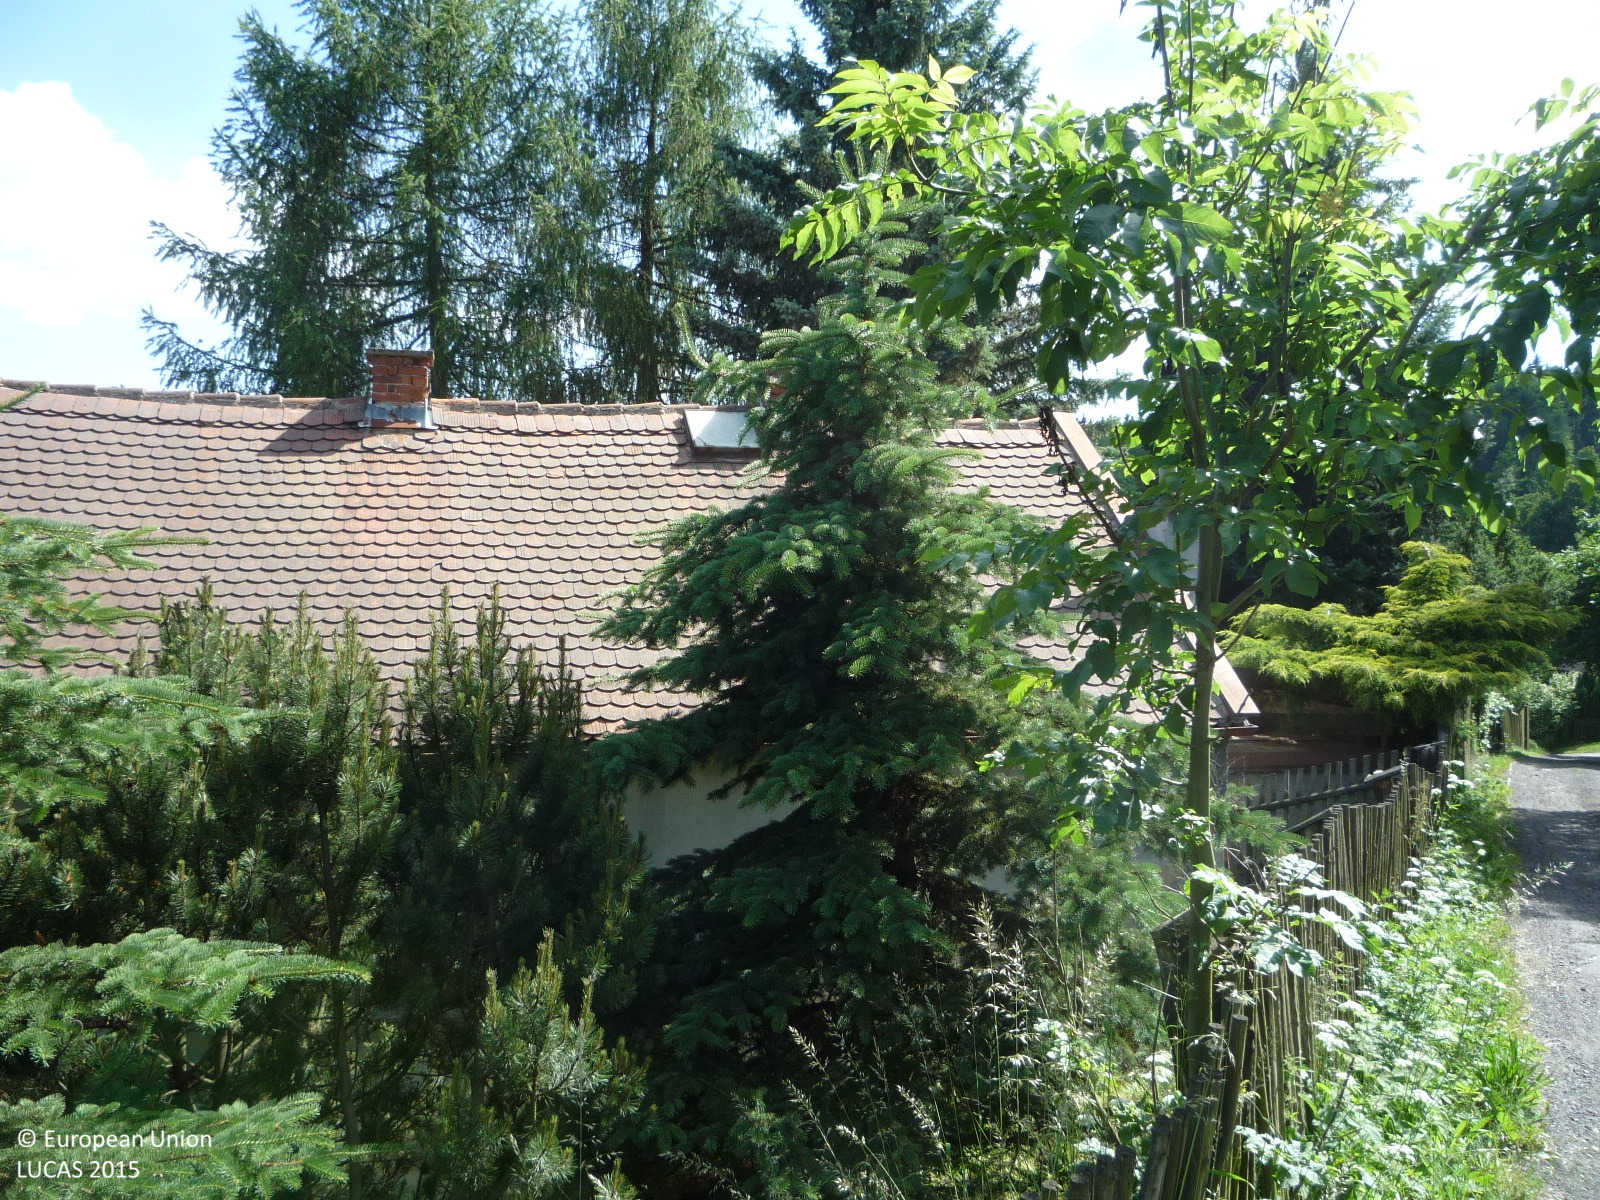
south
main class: Cropland
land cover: Apple fruit
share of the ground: 25 - 50 %
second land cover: Grassland without tree/shrub cover
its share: 50 - 75 %
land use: Kitchen garden
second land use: Residential
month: June
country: CZ
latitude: 50.4964
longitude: 13.8776
